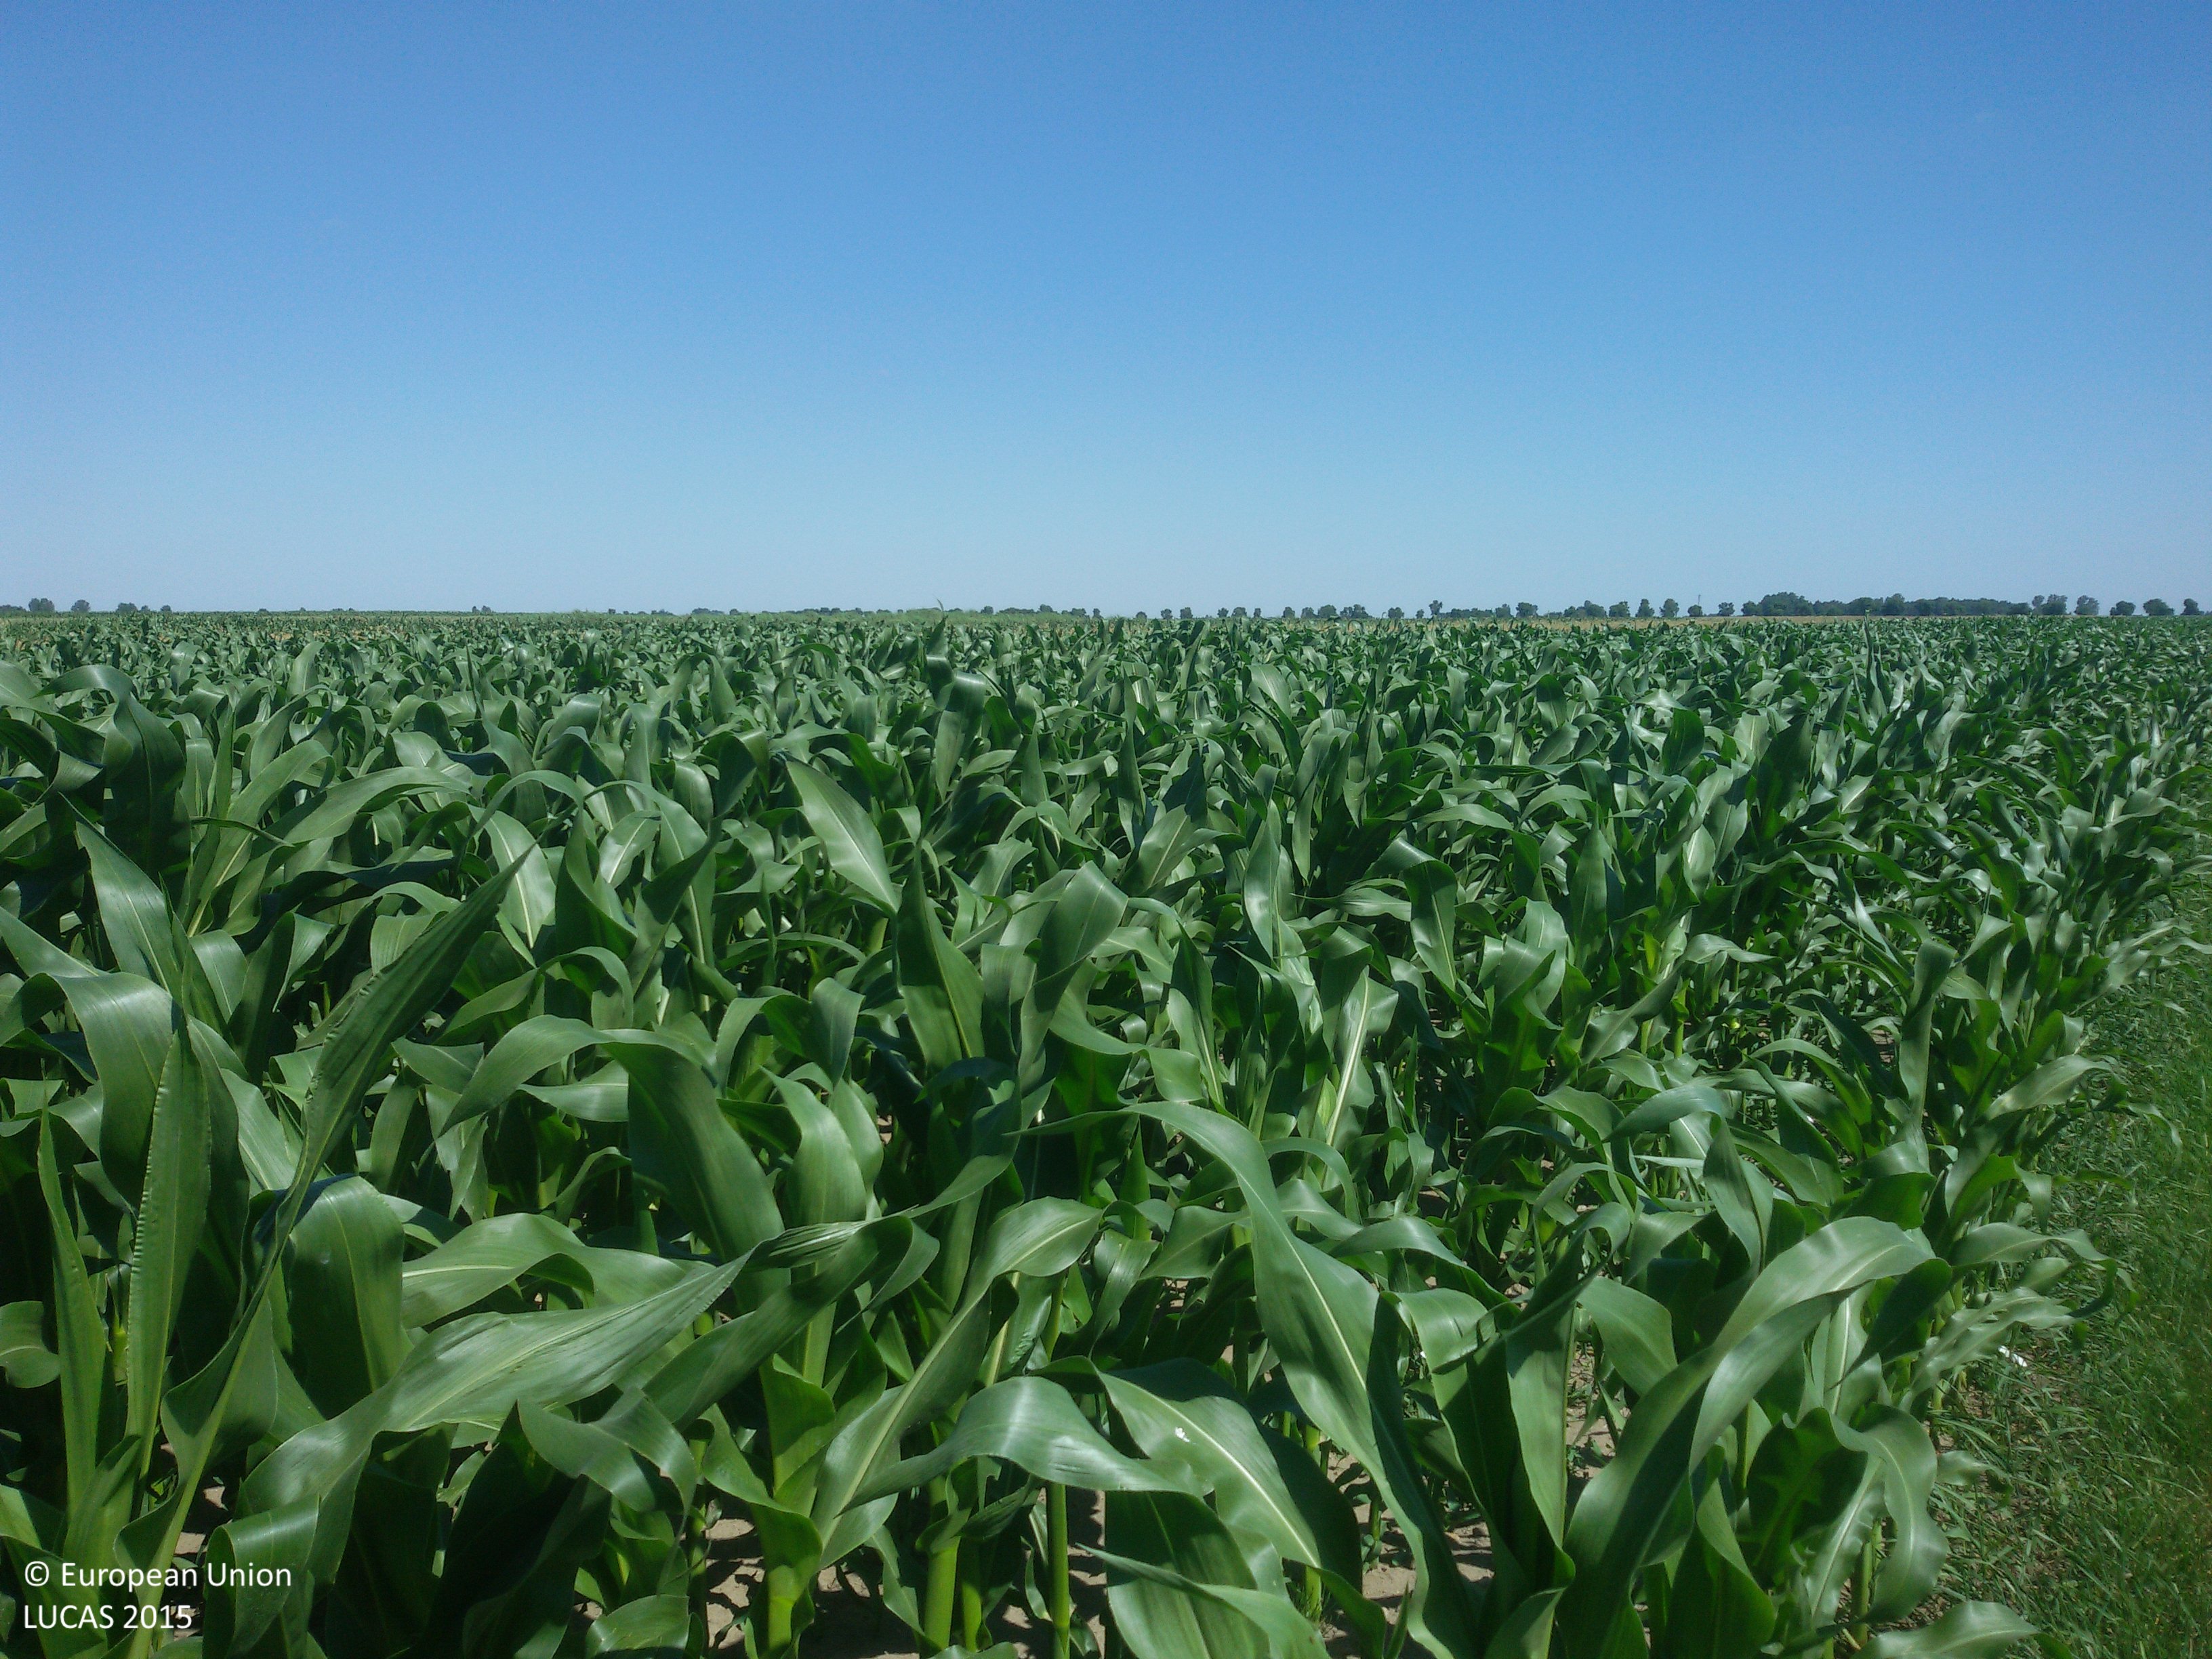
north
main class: Cropland
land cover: Maize
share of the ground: > 75 %
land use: Agriculture (excluding fallow land and kitchen gardens)
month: July
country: PL
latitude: 51.6260
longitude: 19.8105
